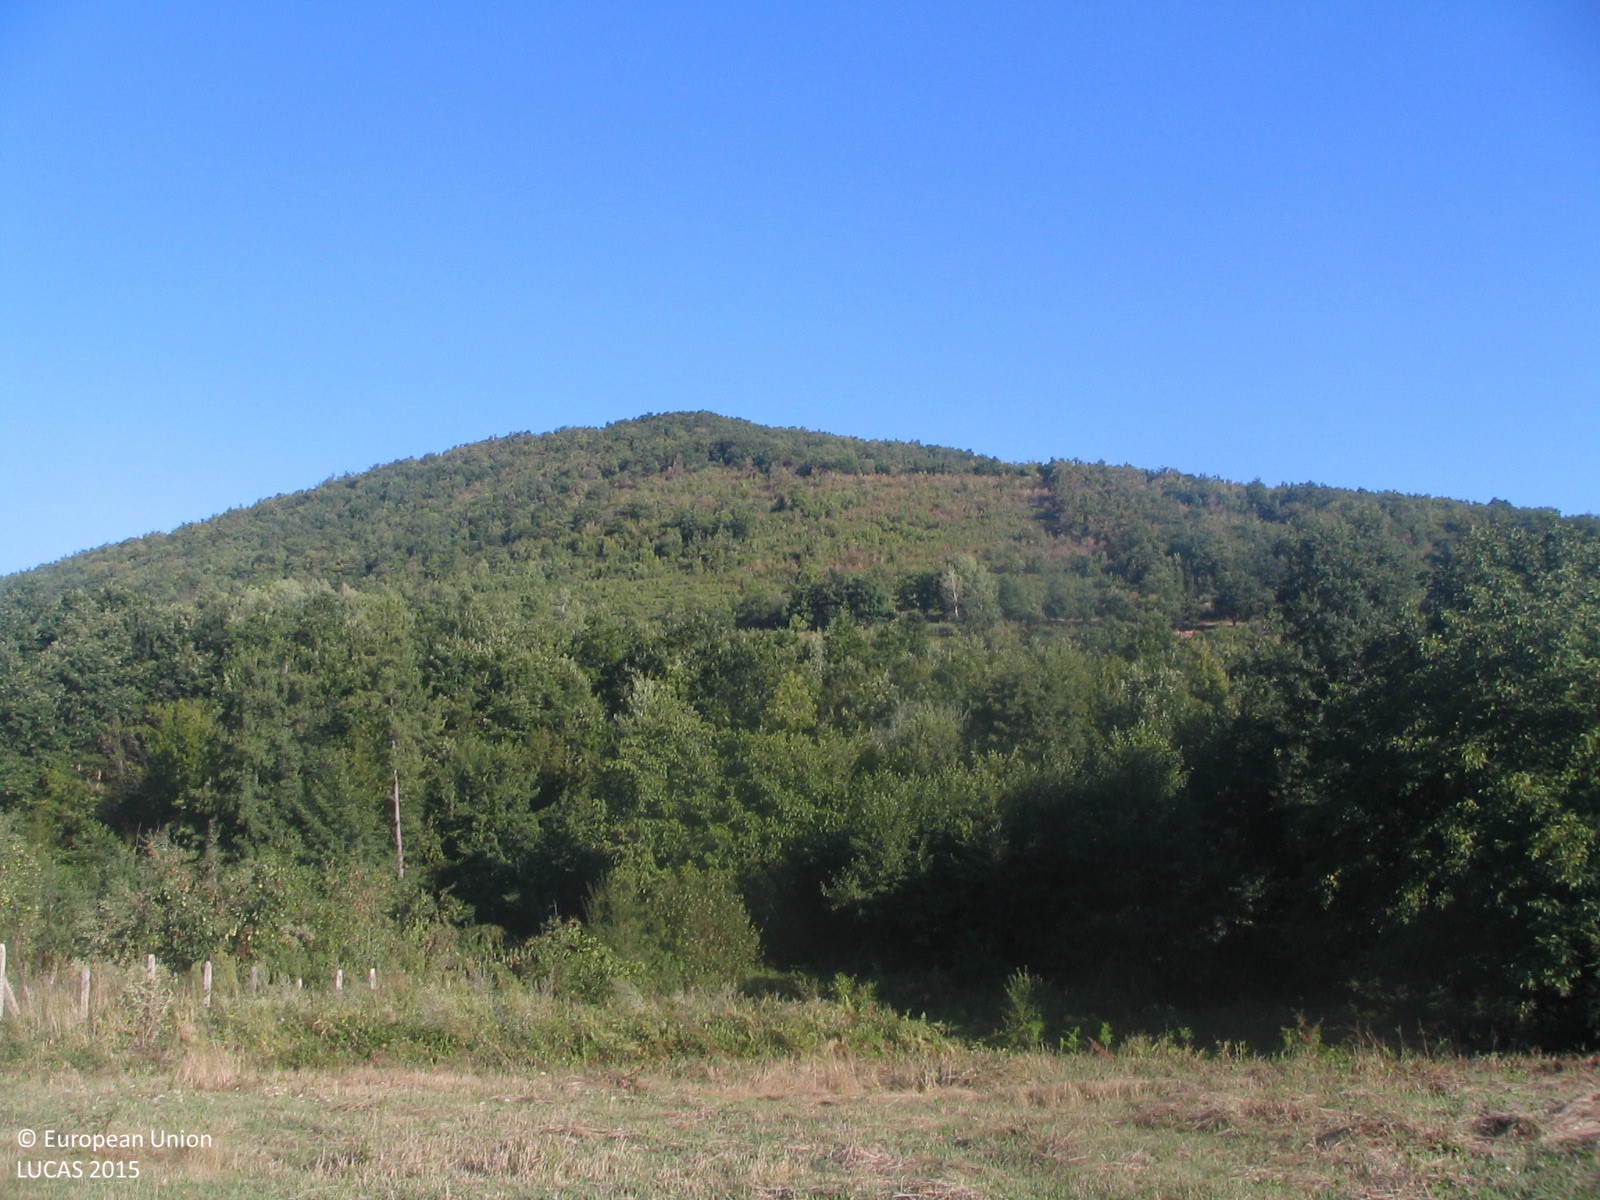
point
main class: Woodland
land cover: Broadleaved woodland
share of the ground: 50 - 75 %
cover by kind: broadleaved forest trees 60 %, shrubs 25 %, herbaceous plants 15 %
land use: Abandoned areas
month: September
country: BG
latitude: 42.9579
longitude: 24.3840
